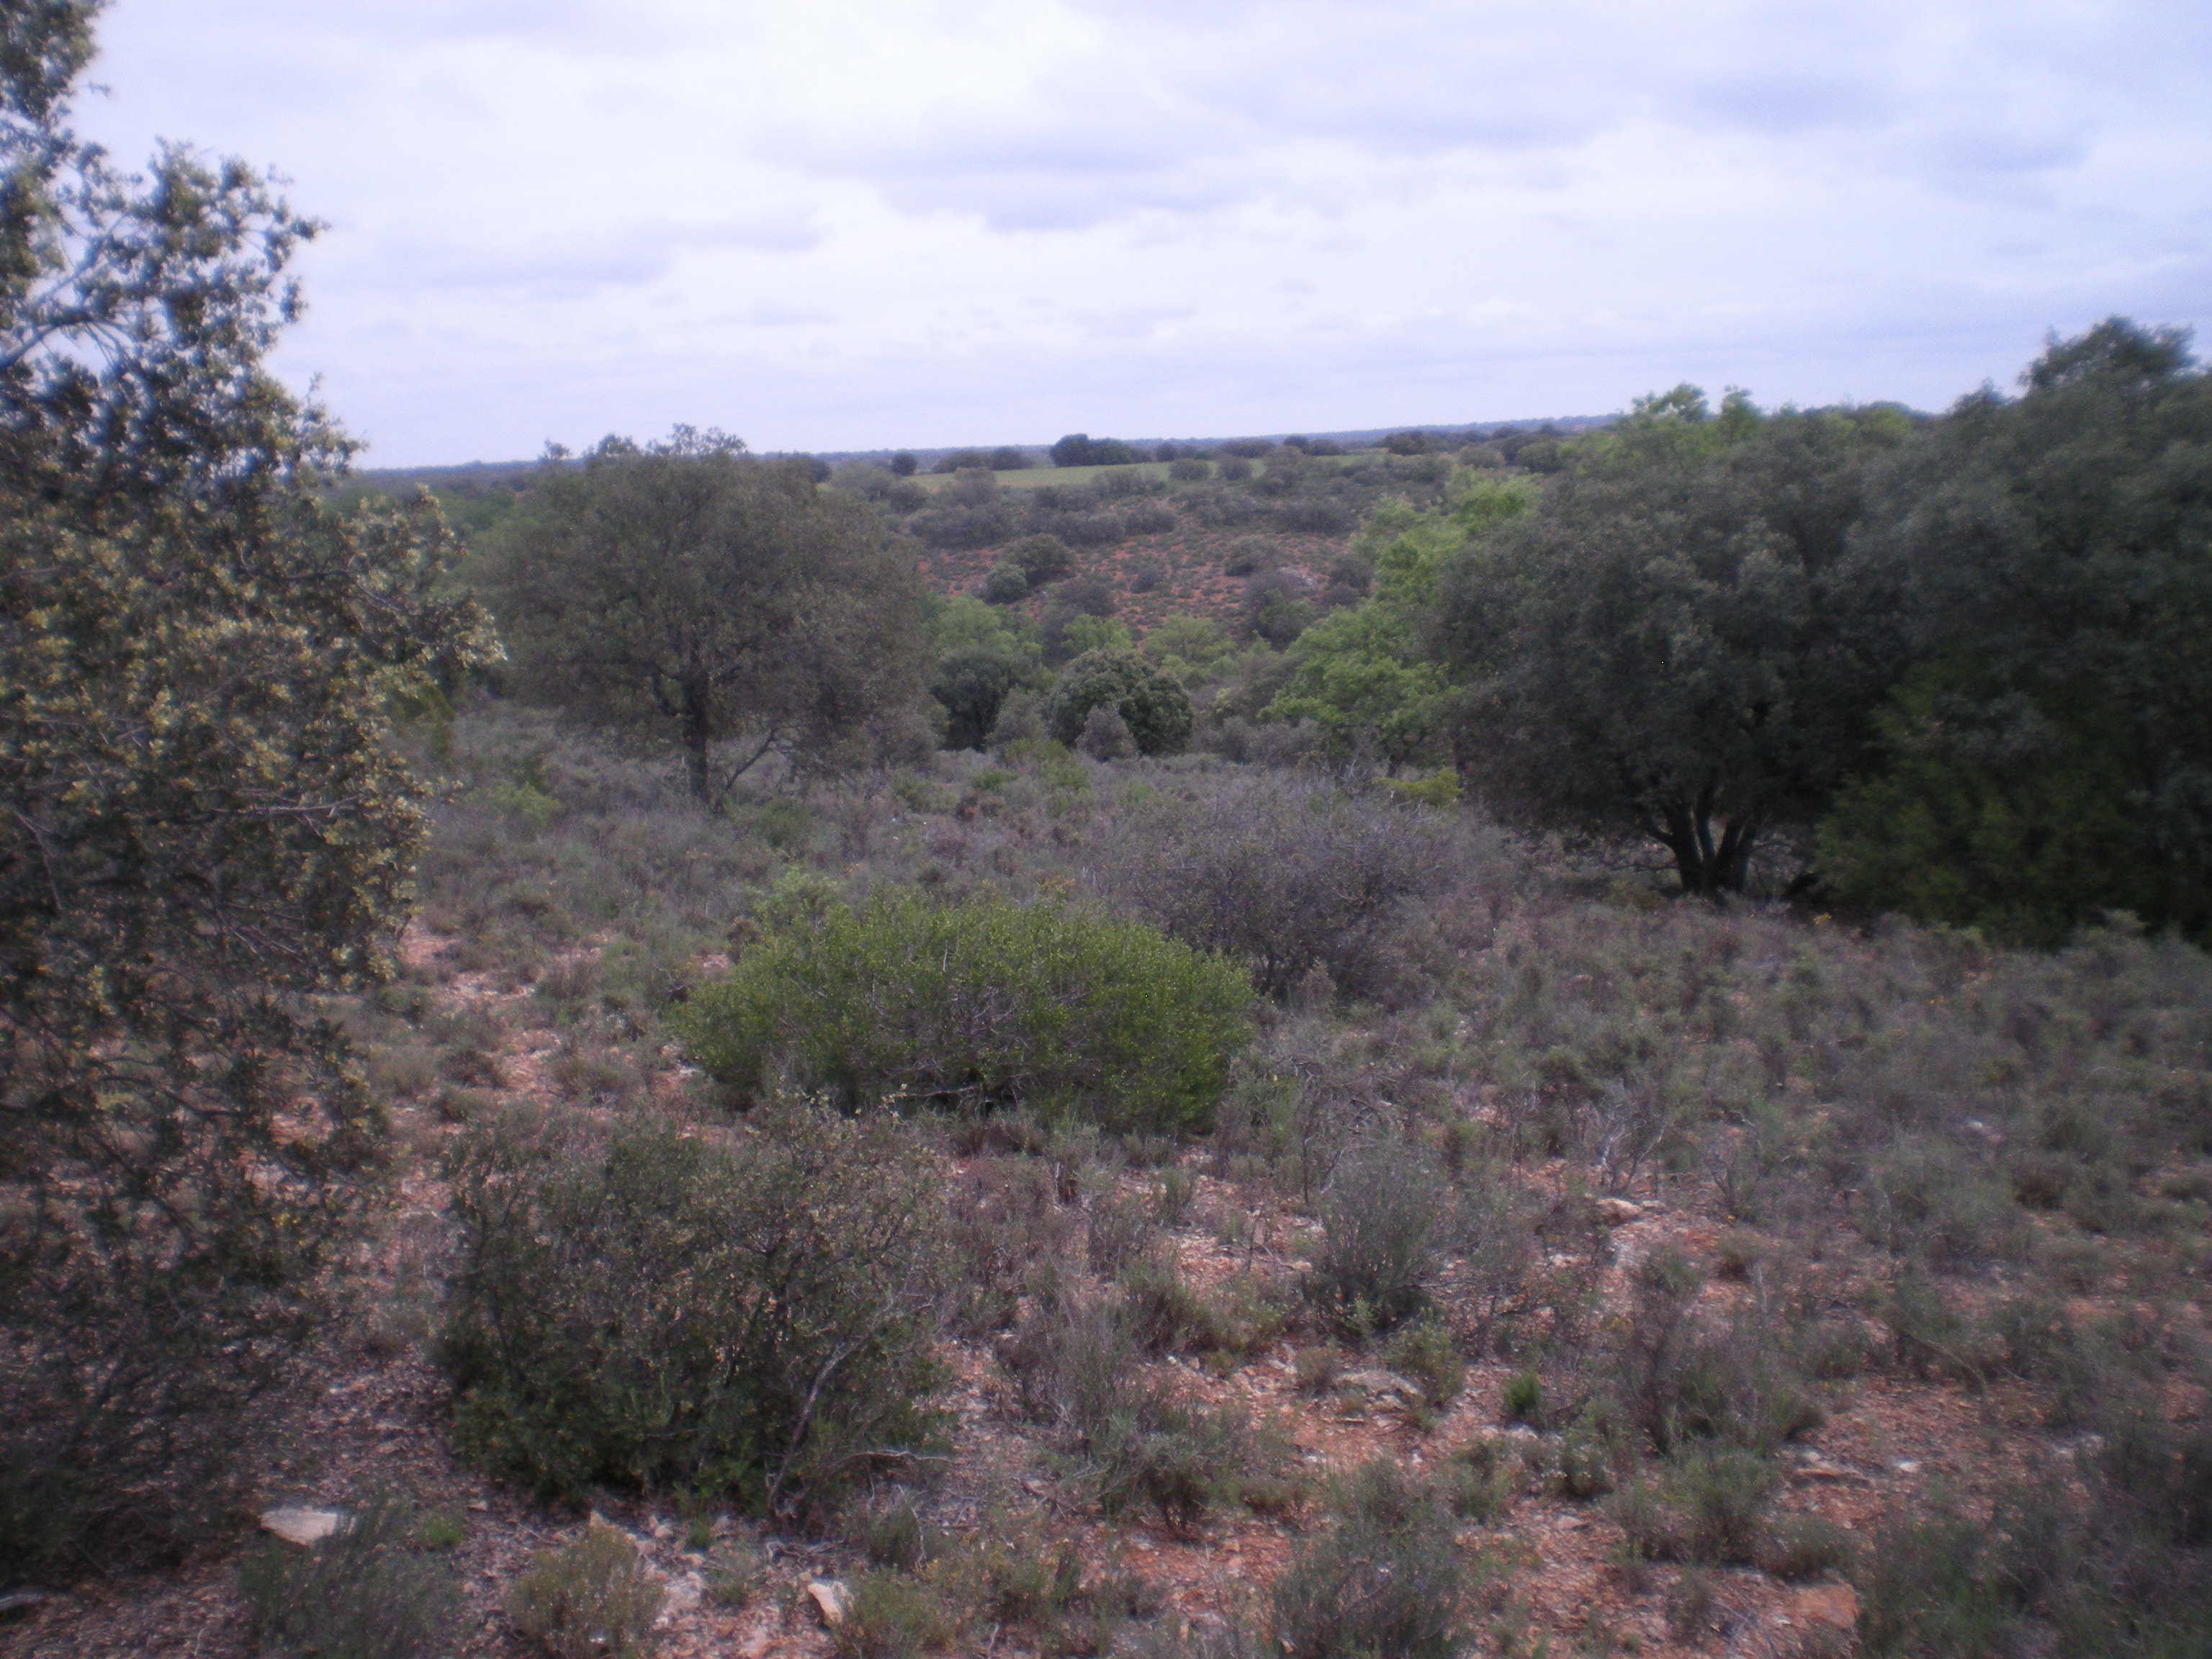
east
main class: Woodland
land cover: Broadleaved woodland
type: broadleaved evergreen forest
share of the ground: 50 - 75 %
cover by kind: shrubs 50 %, unconsolidated bare surface 35 %, broadleaved forest trees 15 %
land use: Other primary production
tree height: < 5 m
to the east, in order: Broadleaved woodland
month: May
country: ES
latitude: 38.8413
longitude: -2.9224
